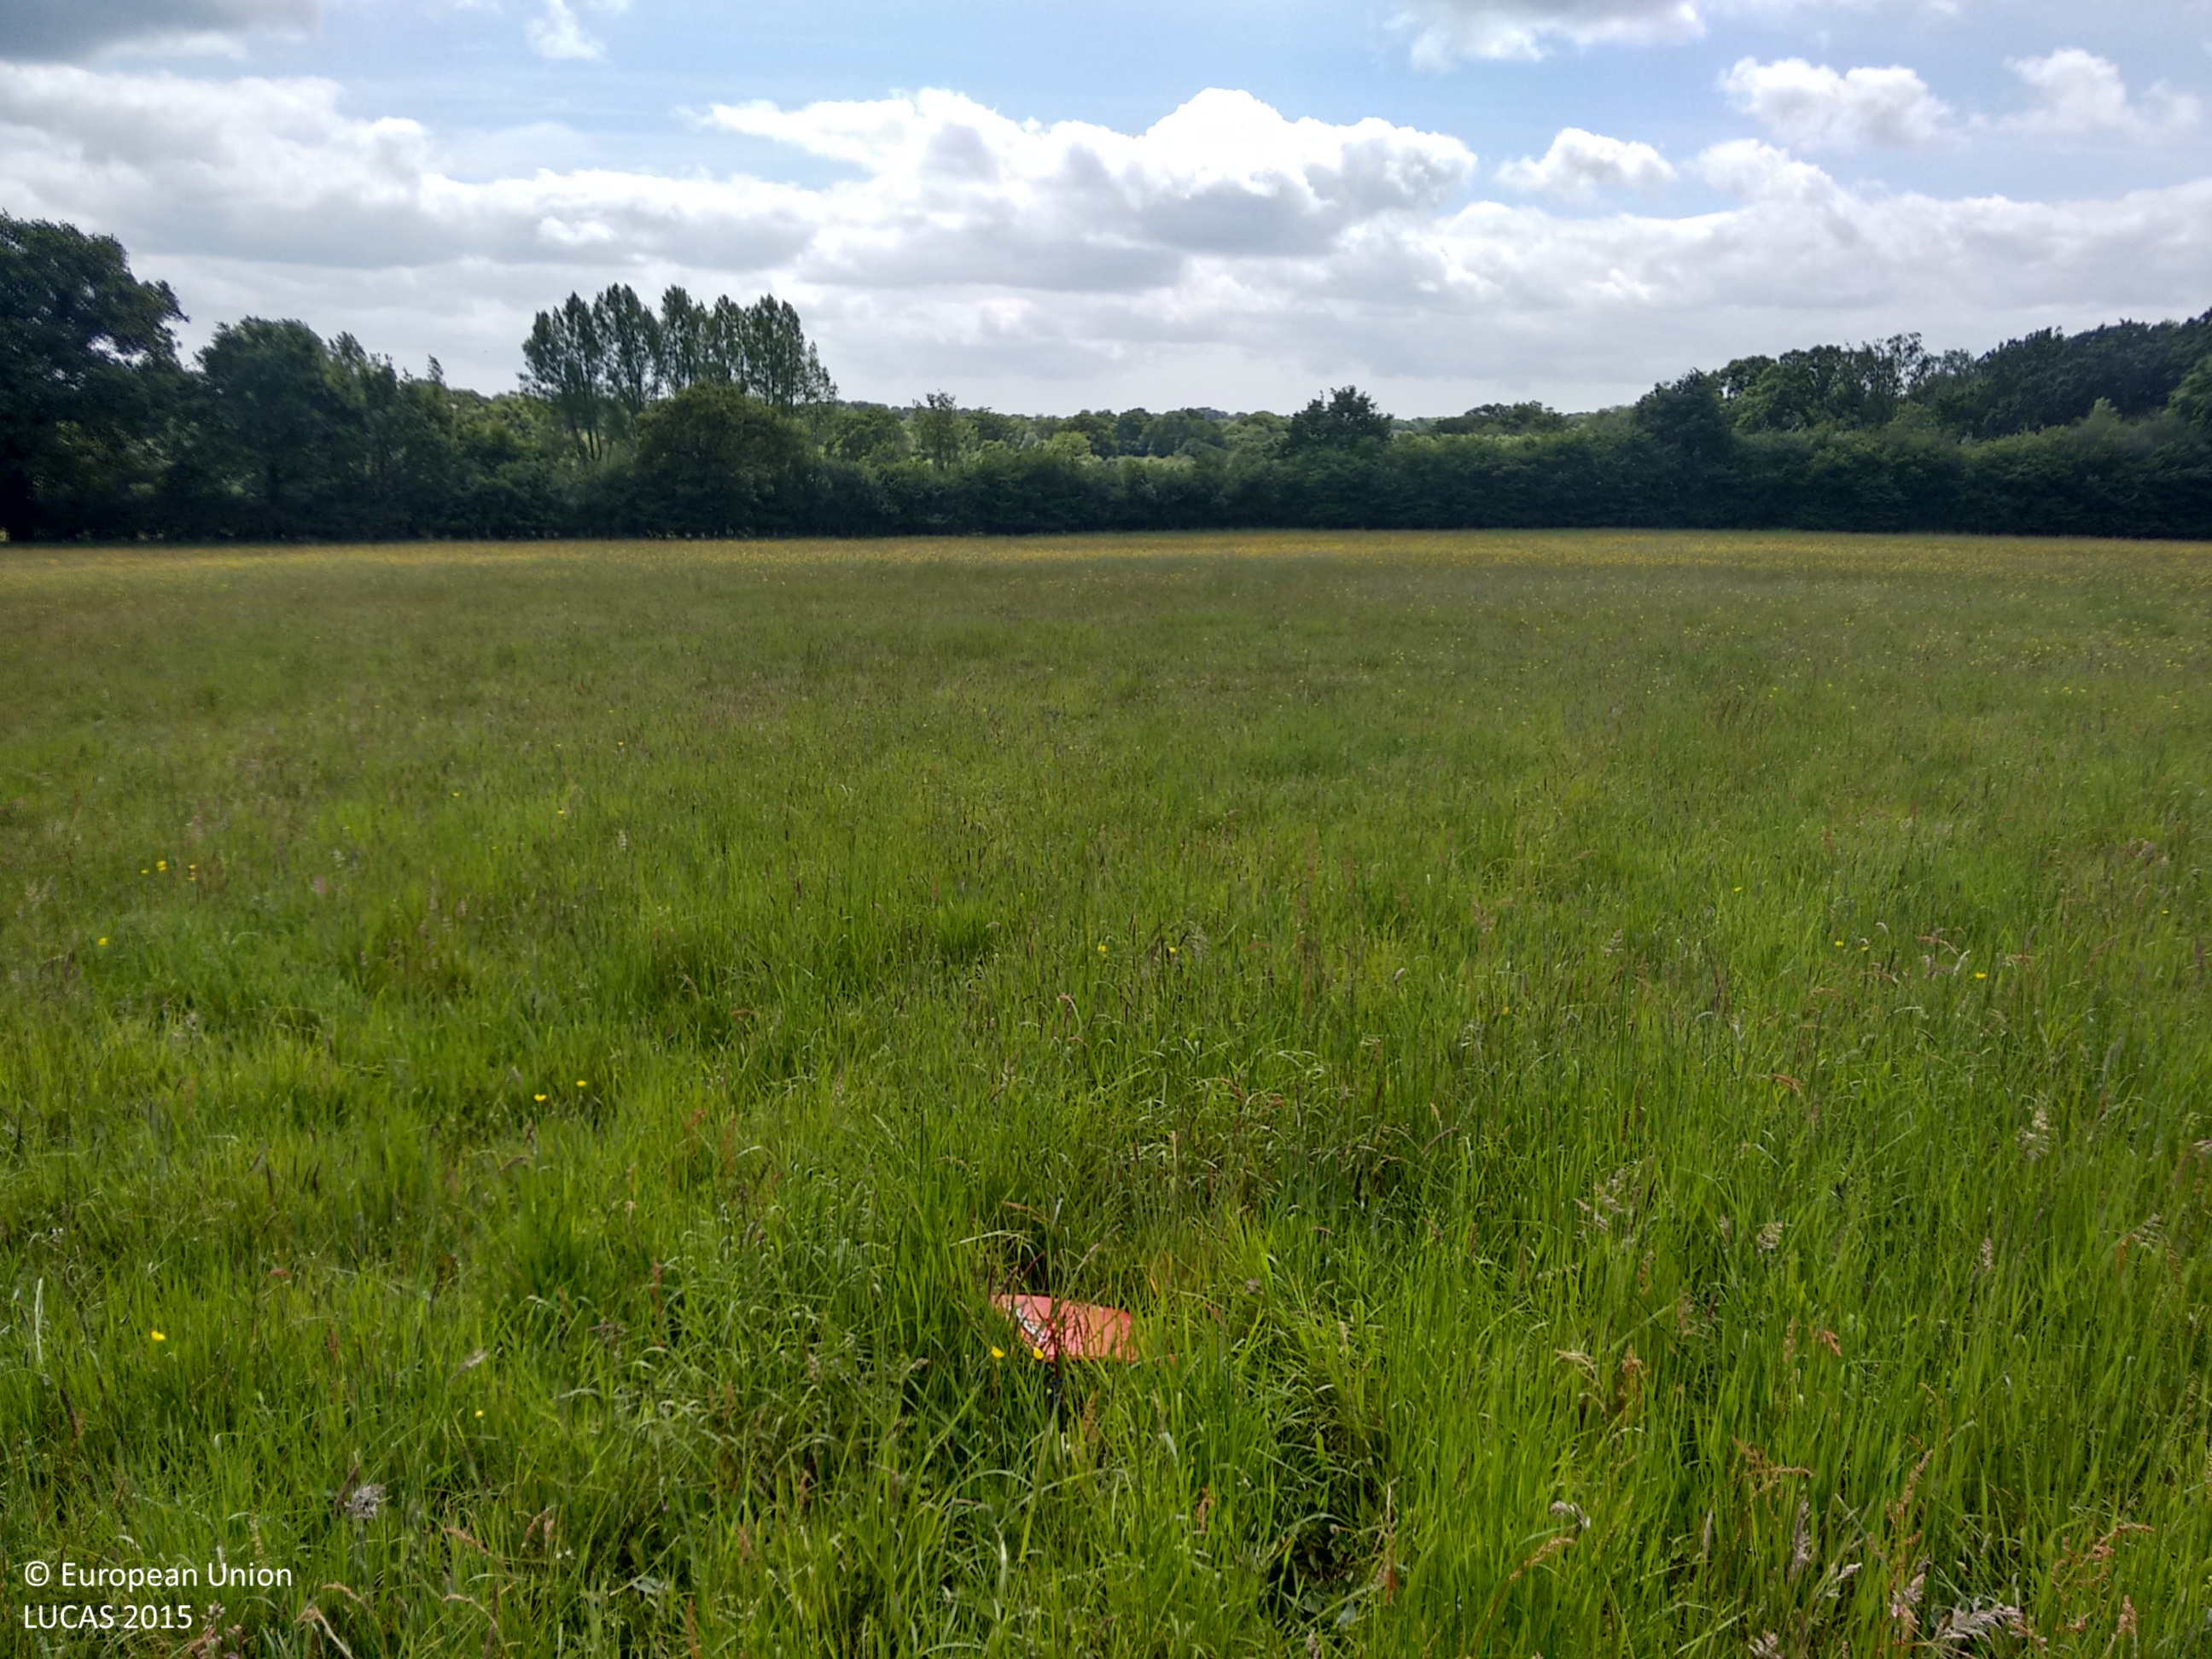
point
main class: Grassland
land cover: Grassland without tree/shrub cover
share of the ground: > 75 %
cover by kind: herbaceous plants 100 %
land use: Agriculture (excluding fallow land and kitchen gardens)
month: May
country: GB
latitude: 50.9299
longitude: -1.8224
